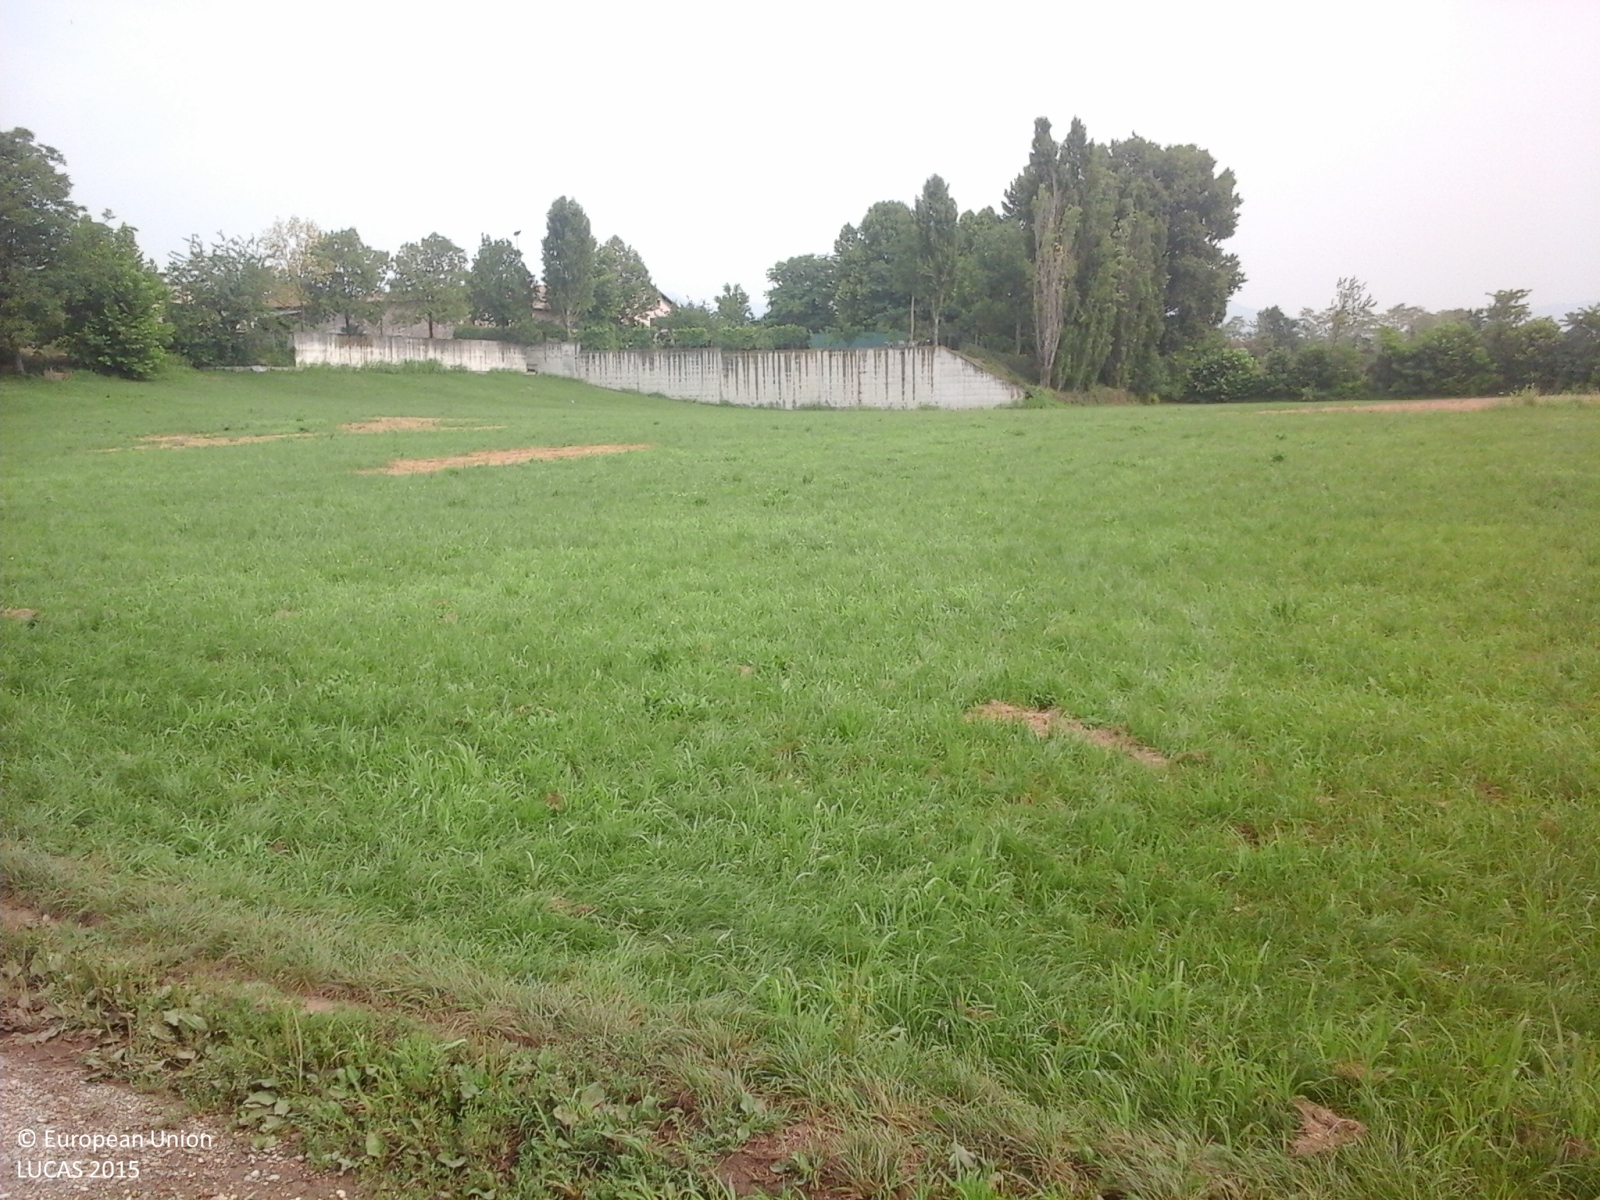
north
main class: Cropland
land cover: Lucerne
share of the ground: > 75 %
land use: Agriculture (excluding fallow land and kitchen gardens)
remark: Harvested field
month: July
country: IT
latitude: 45.4856
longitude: 10.3959
